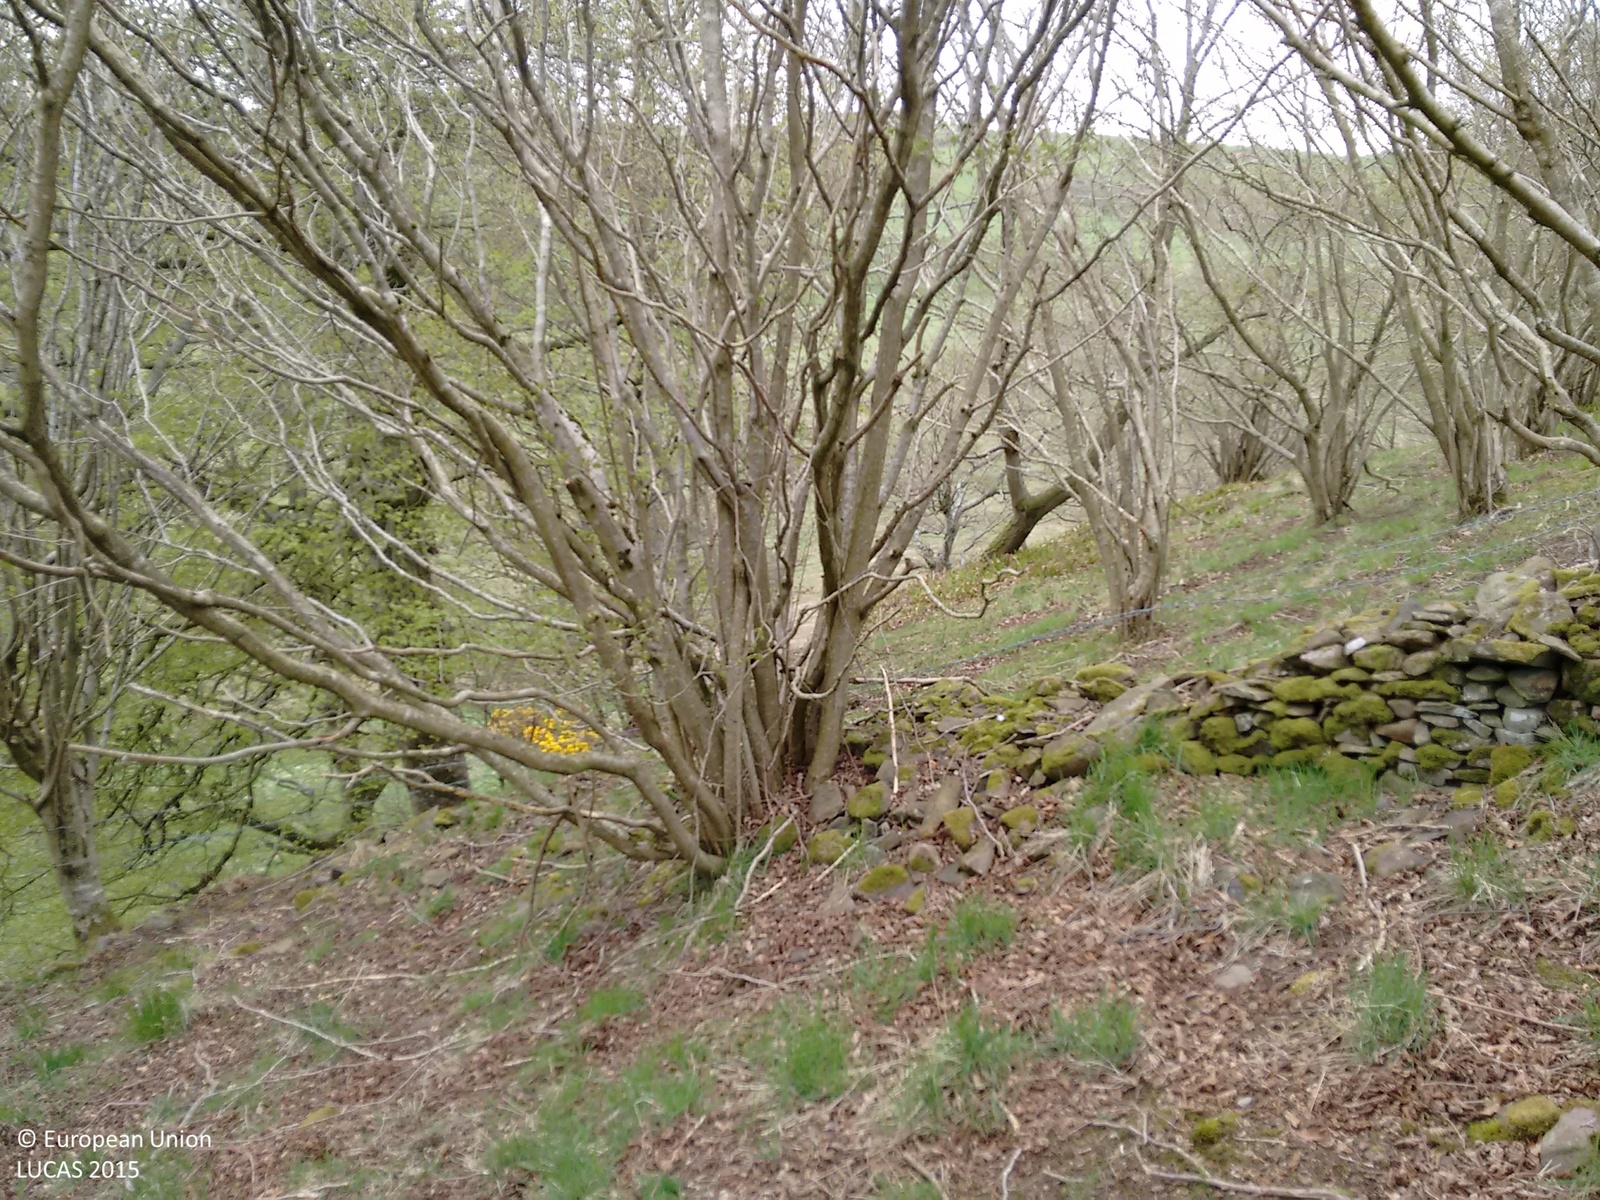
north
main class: Woodland
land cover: Broadleaved woodland
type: floodplain forest
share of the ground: > 75 %
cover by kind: broadleaved forest trees 95 %, herbaceous plants 5 %
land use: Semi-natural and natural areas not in use
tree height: > 5 m
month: May
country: GB
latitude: 55.7188
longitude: -2.6873
